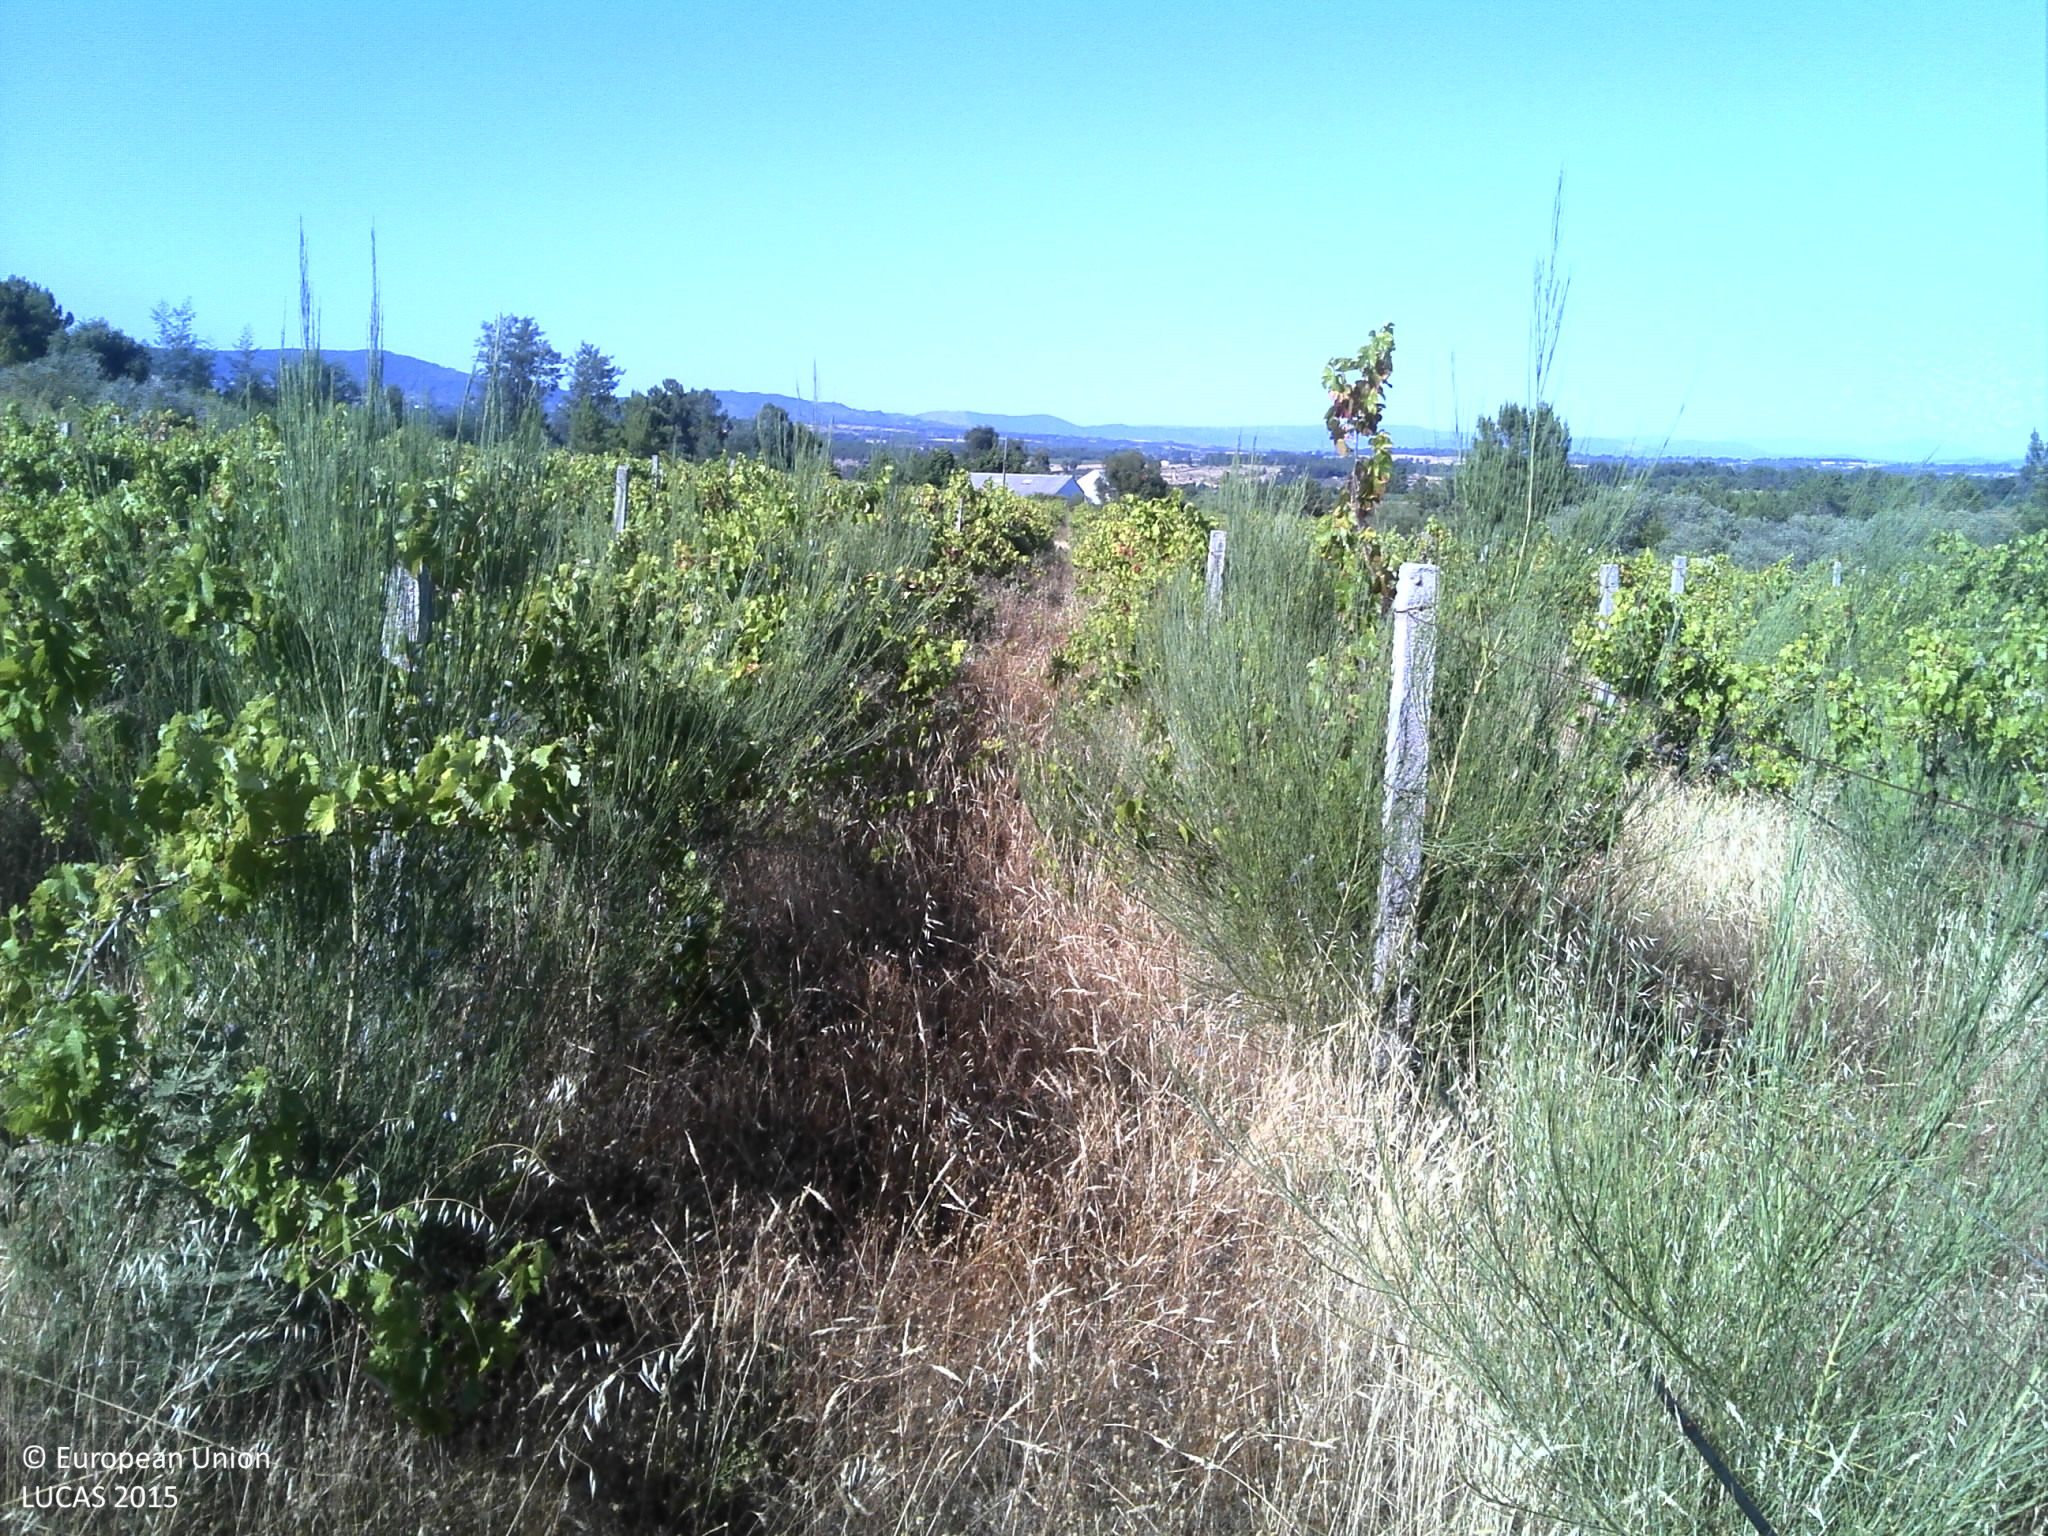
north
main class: Cropland
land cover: Vineyards
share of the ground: 25 - 50 %
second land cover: Spontaneously vegetated surfaces
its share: > 75 %
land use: Agriculture (excluding fallow land and kitchen gardens)
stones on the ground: 10 - 25 %
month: June
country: PT
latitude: 40.0398
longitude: -7.4354
